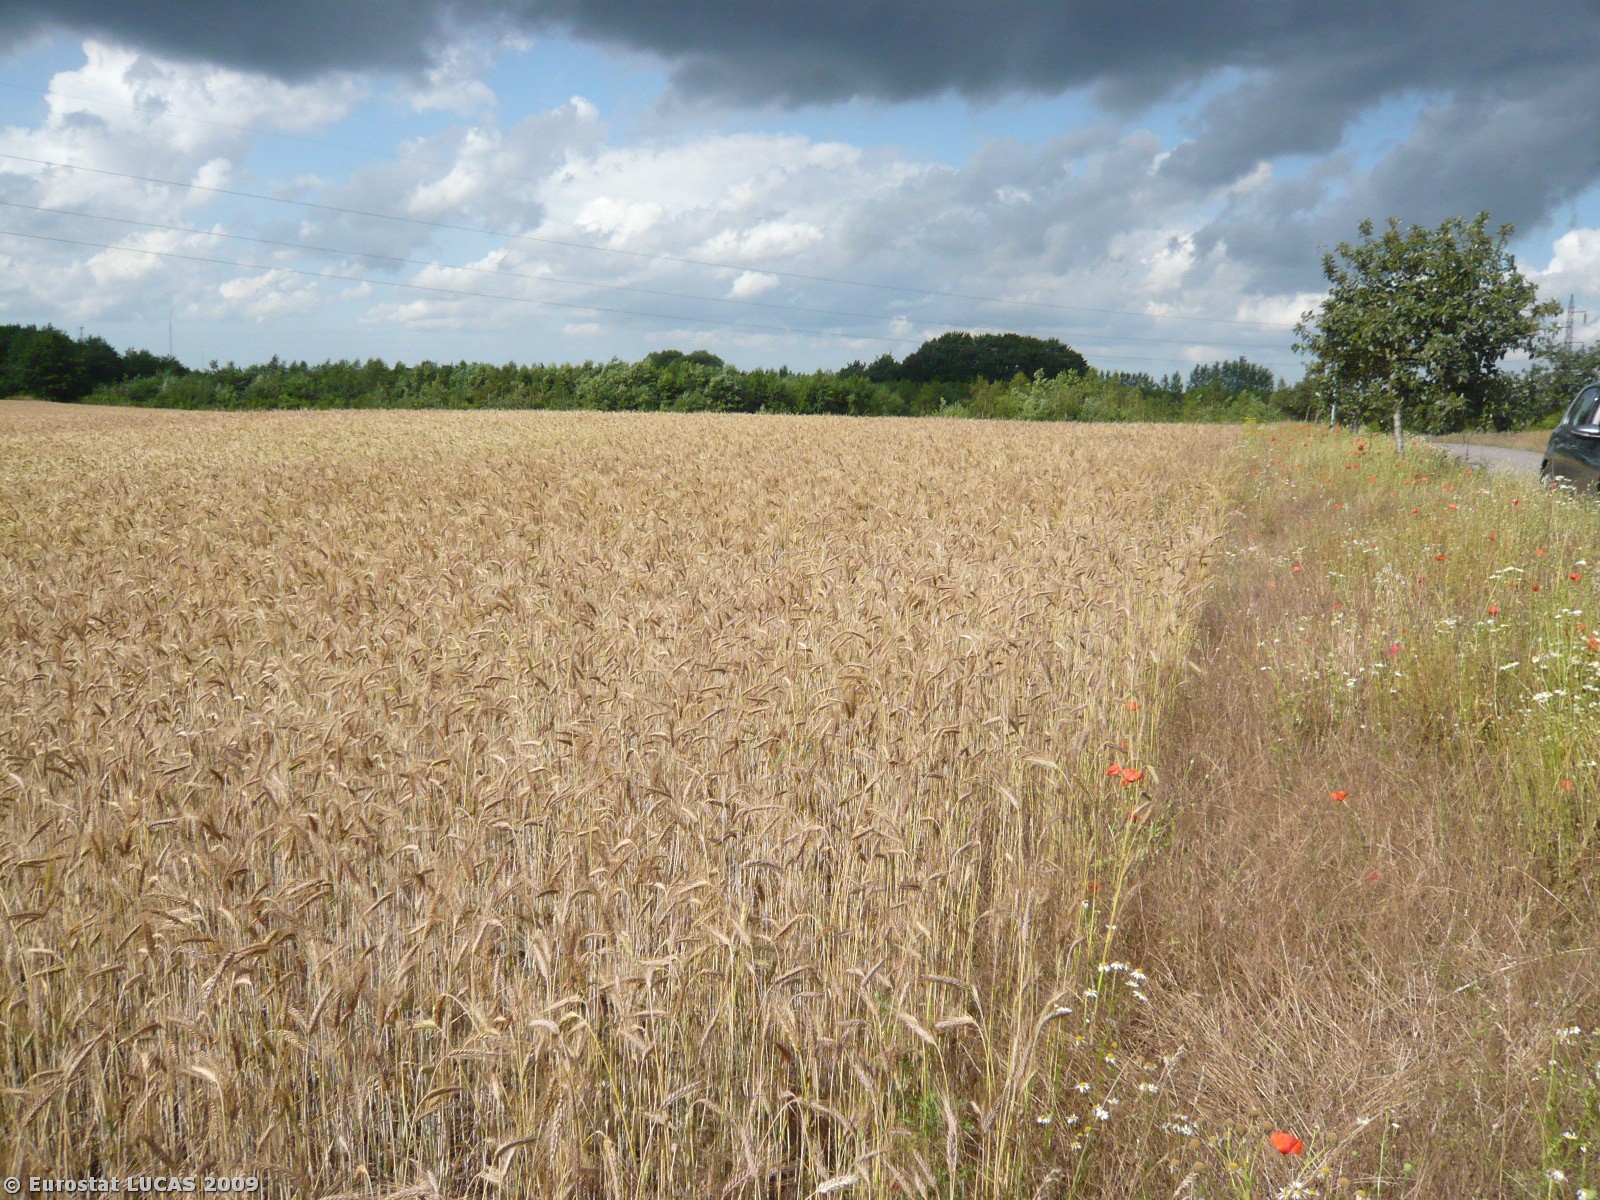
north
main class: Cropland
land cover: Barley
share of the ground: > 75 %
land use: Agriculture (excluding fallow land and kitchen gardens)
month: July
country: DK
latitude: 55.5306
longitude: 11.5987
